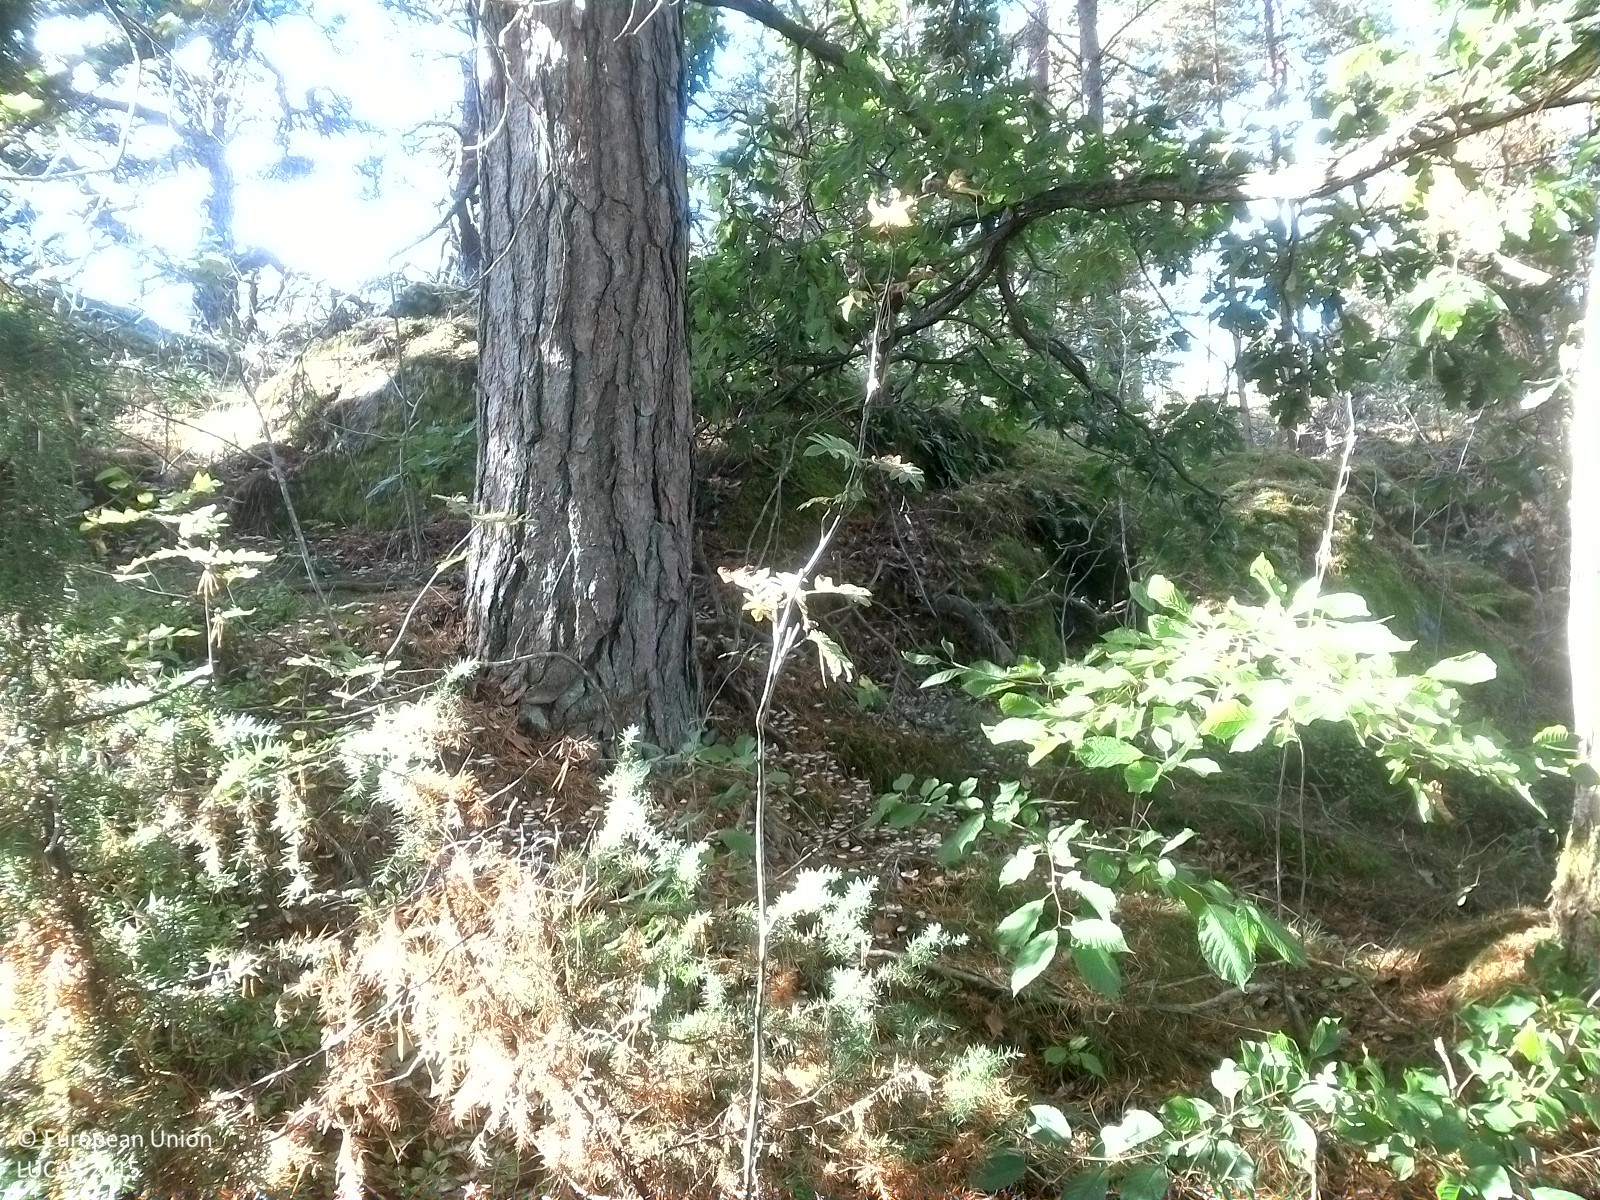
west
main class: Woodland
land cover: Pine dominated mixed woodland
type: boreal forest
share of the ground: 25 - 50 %
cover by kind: herbaceous plants 45 %, coniferous forest trees 25 %, broadleaved forest trees 20 %, shrubs 5 %, lichens and mosses 5 %
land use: Forestry
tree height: > 5 m
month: September
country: SE
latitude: 58.4932
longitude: 16.9112
